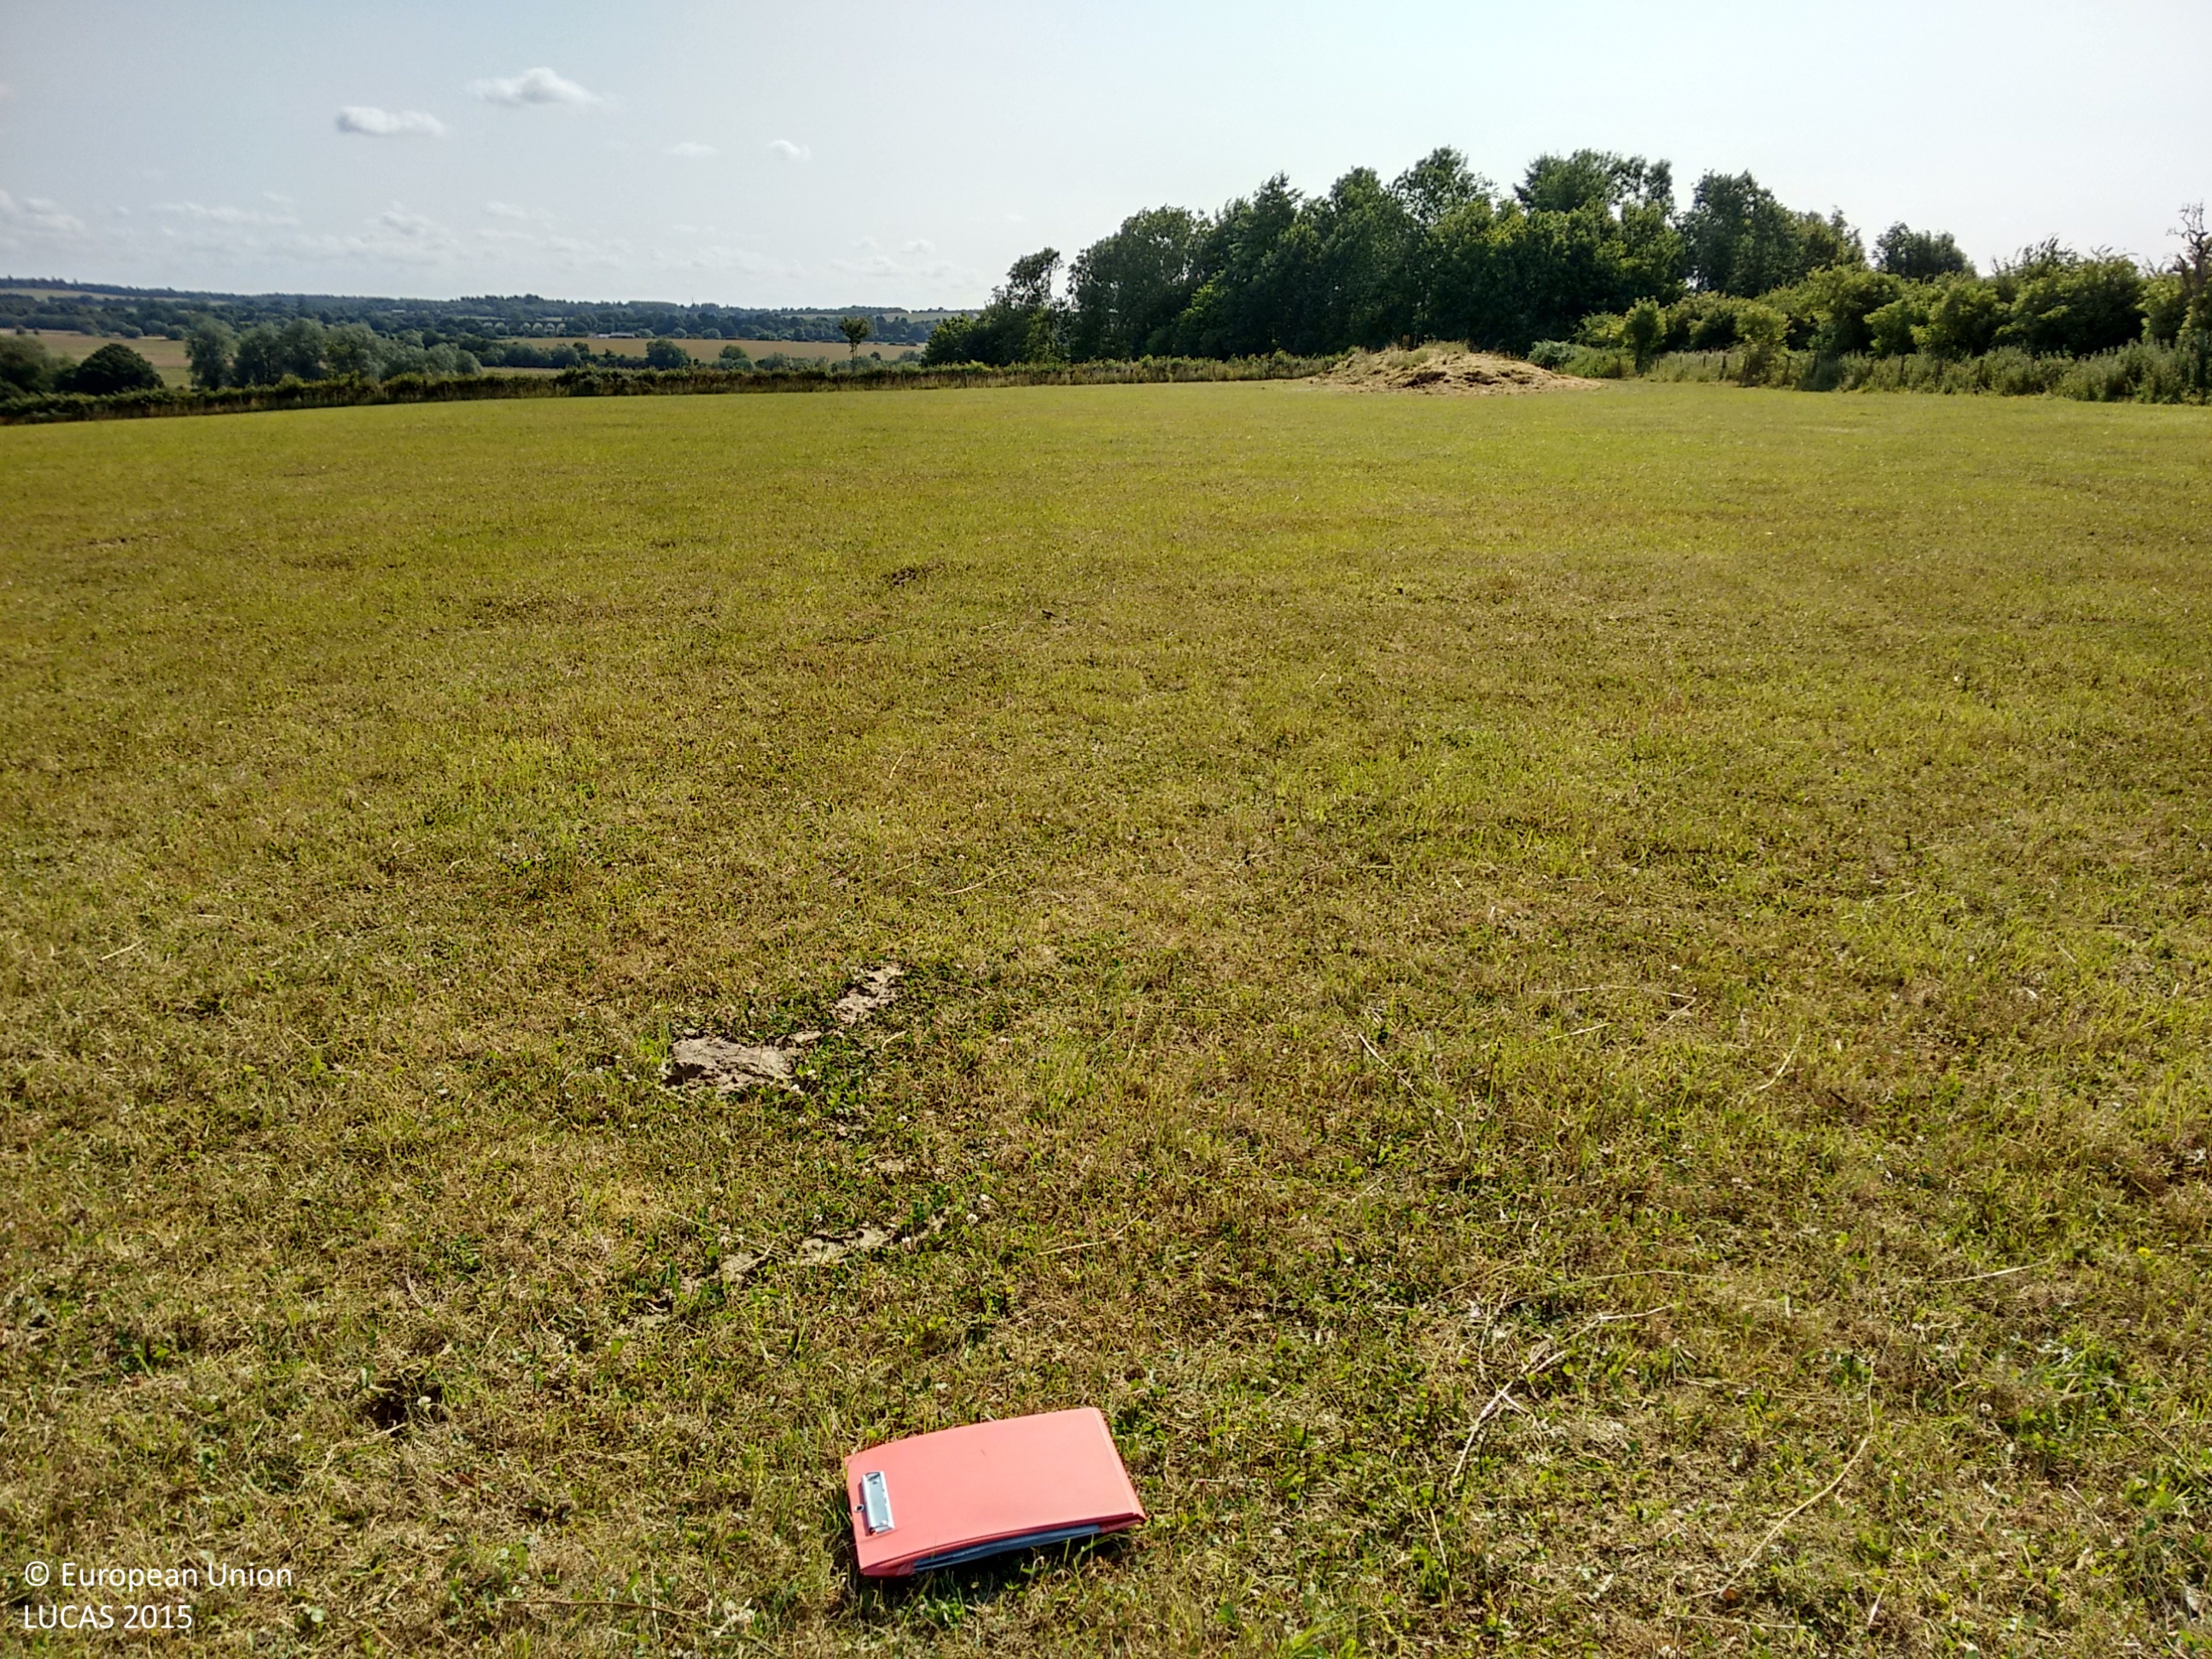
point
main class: Grassland
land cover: Grassland without tree/shrub cover
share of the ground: > 75 %
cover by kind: herbaceous plants 100 %
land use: Agriculture (excluding fallow land and kitchen gardens)
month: July
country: GB
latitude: 51.9632
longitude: -1.2985
